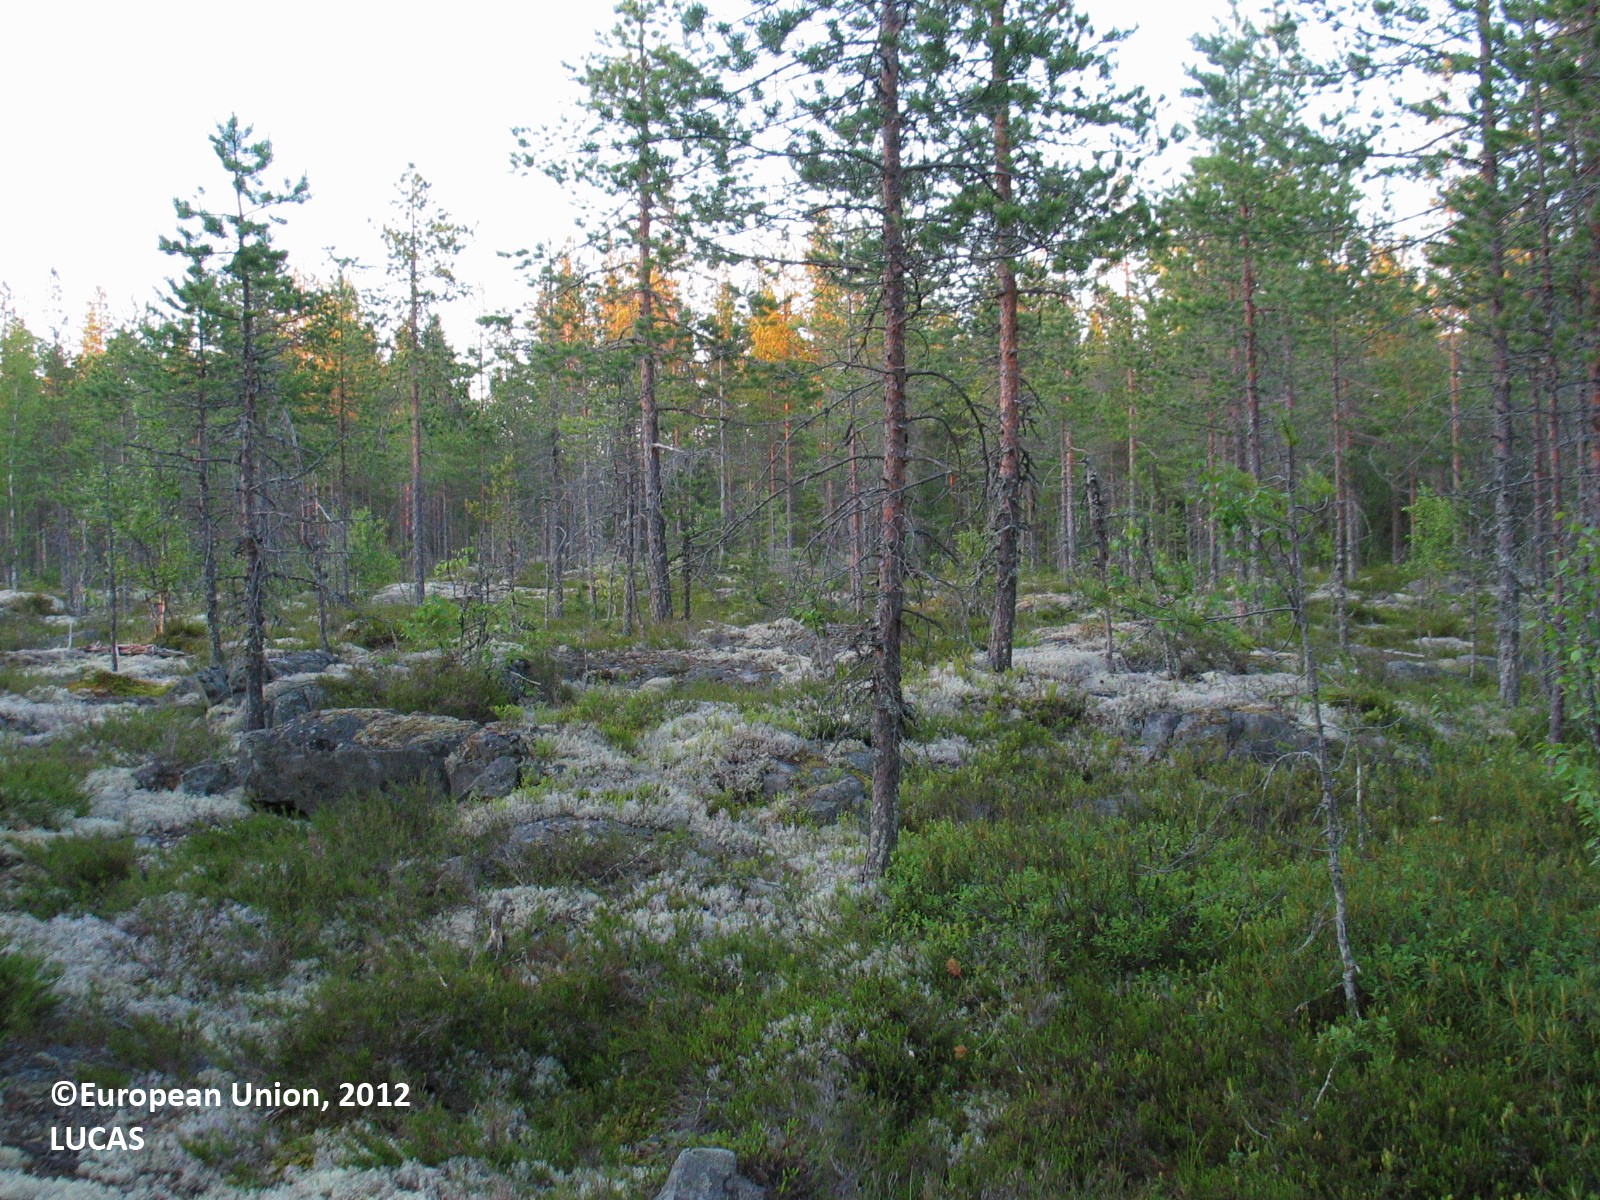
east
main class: Woodland
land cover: Pine dominated coniferous woodland
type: boreal forest
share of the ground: 10 - 25 %
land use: Forestry
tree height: > 5 m
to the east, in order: Pine dominated coniferous woodland; Lichens and moss; Pine dominated coniferous woodland; Lichens and moss; Pine dominated coniferous woodland; Lichens and moss; Pine dominated coniferous woodland; Lichens and moss; Pine dominated coniferous woodland
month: July
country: FI
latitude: 64.7695
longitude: 26.6627
